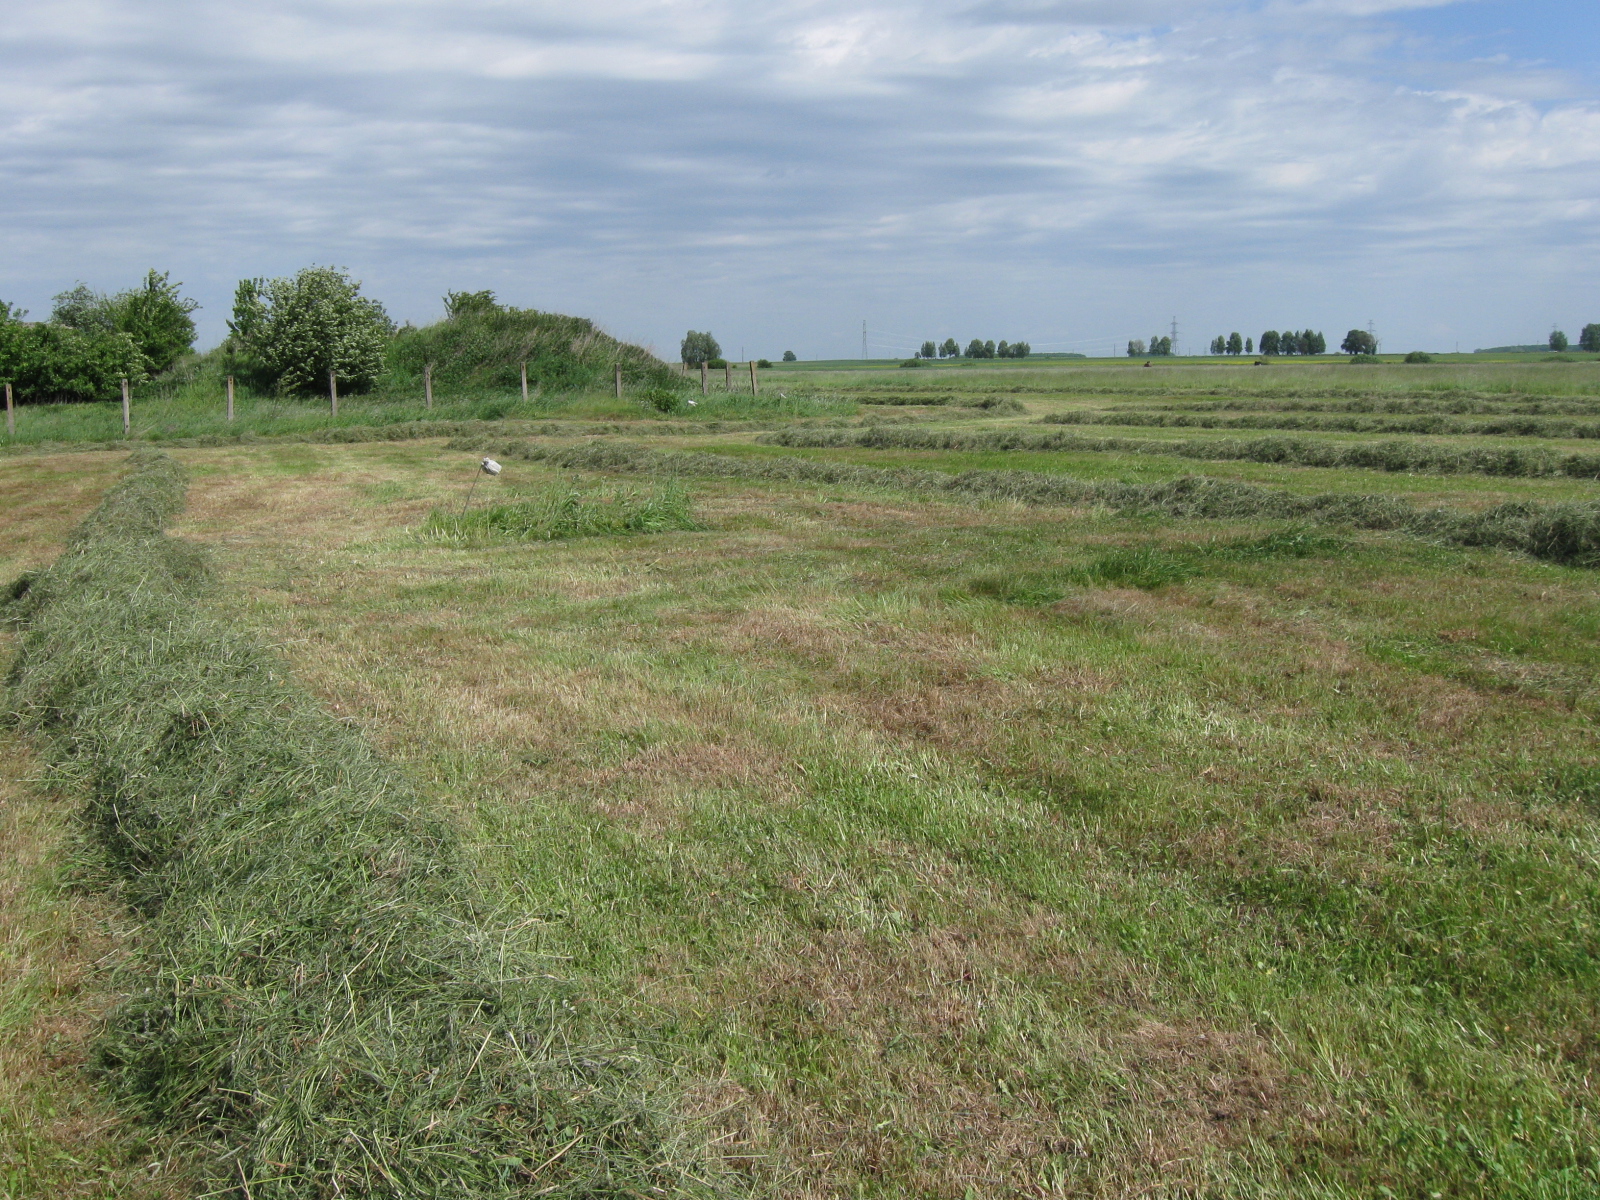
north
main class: Grassland
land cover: Grassland without tree/shrub cover
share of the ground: > 75 %
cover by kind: herbaceous plants 95 %, unconsolidated bare surface 5 %
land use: Agriculture (excluding fallow land and kitchen gardens)
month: June
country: LT
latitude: 54.3907
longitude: 23.6843
